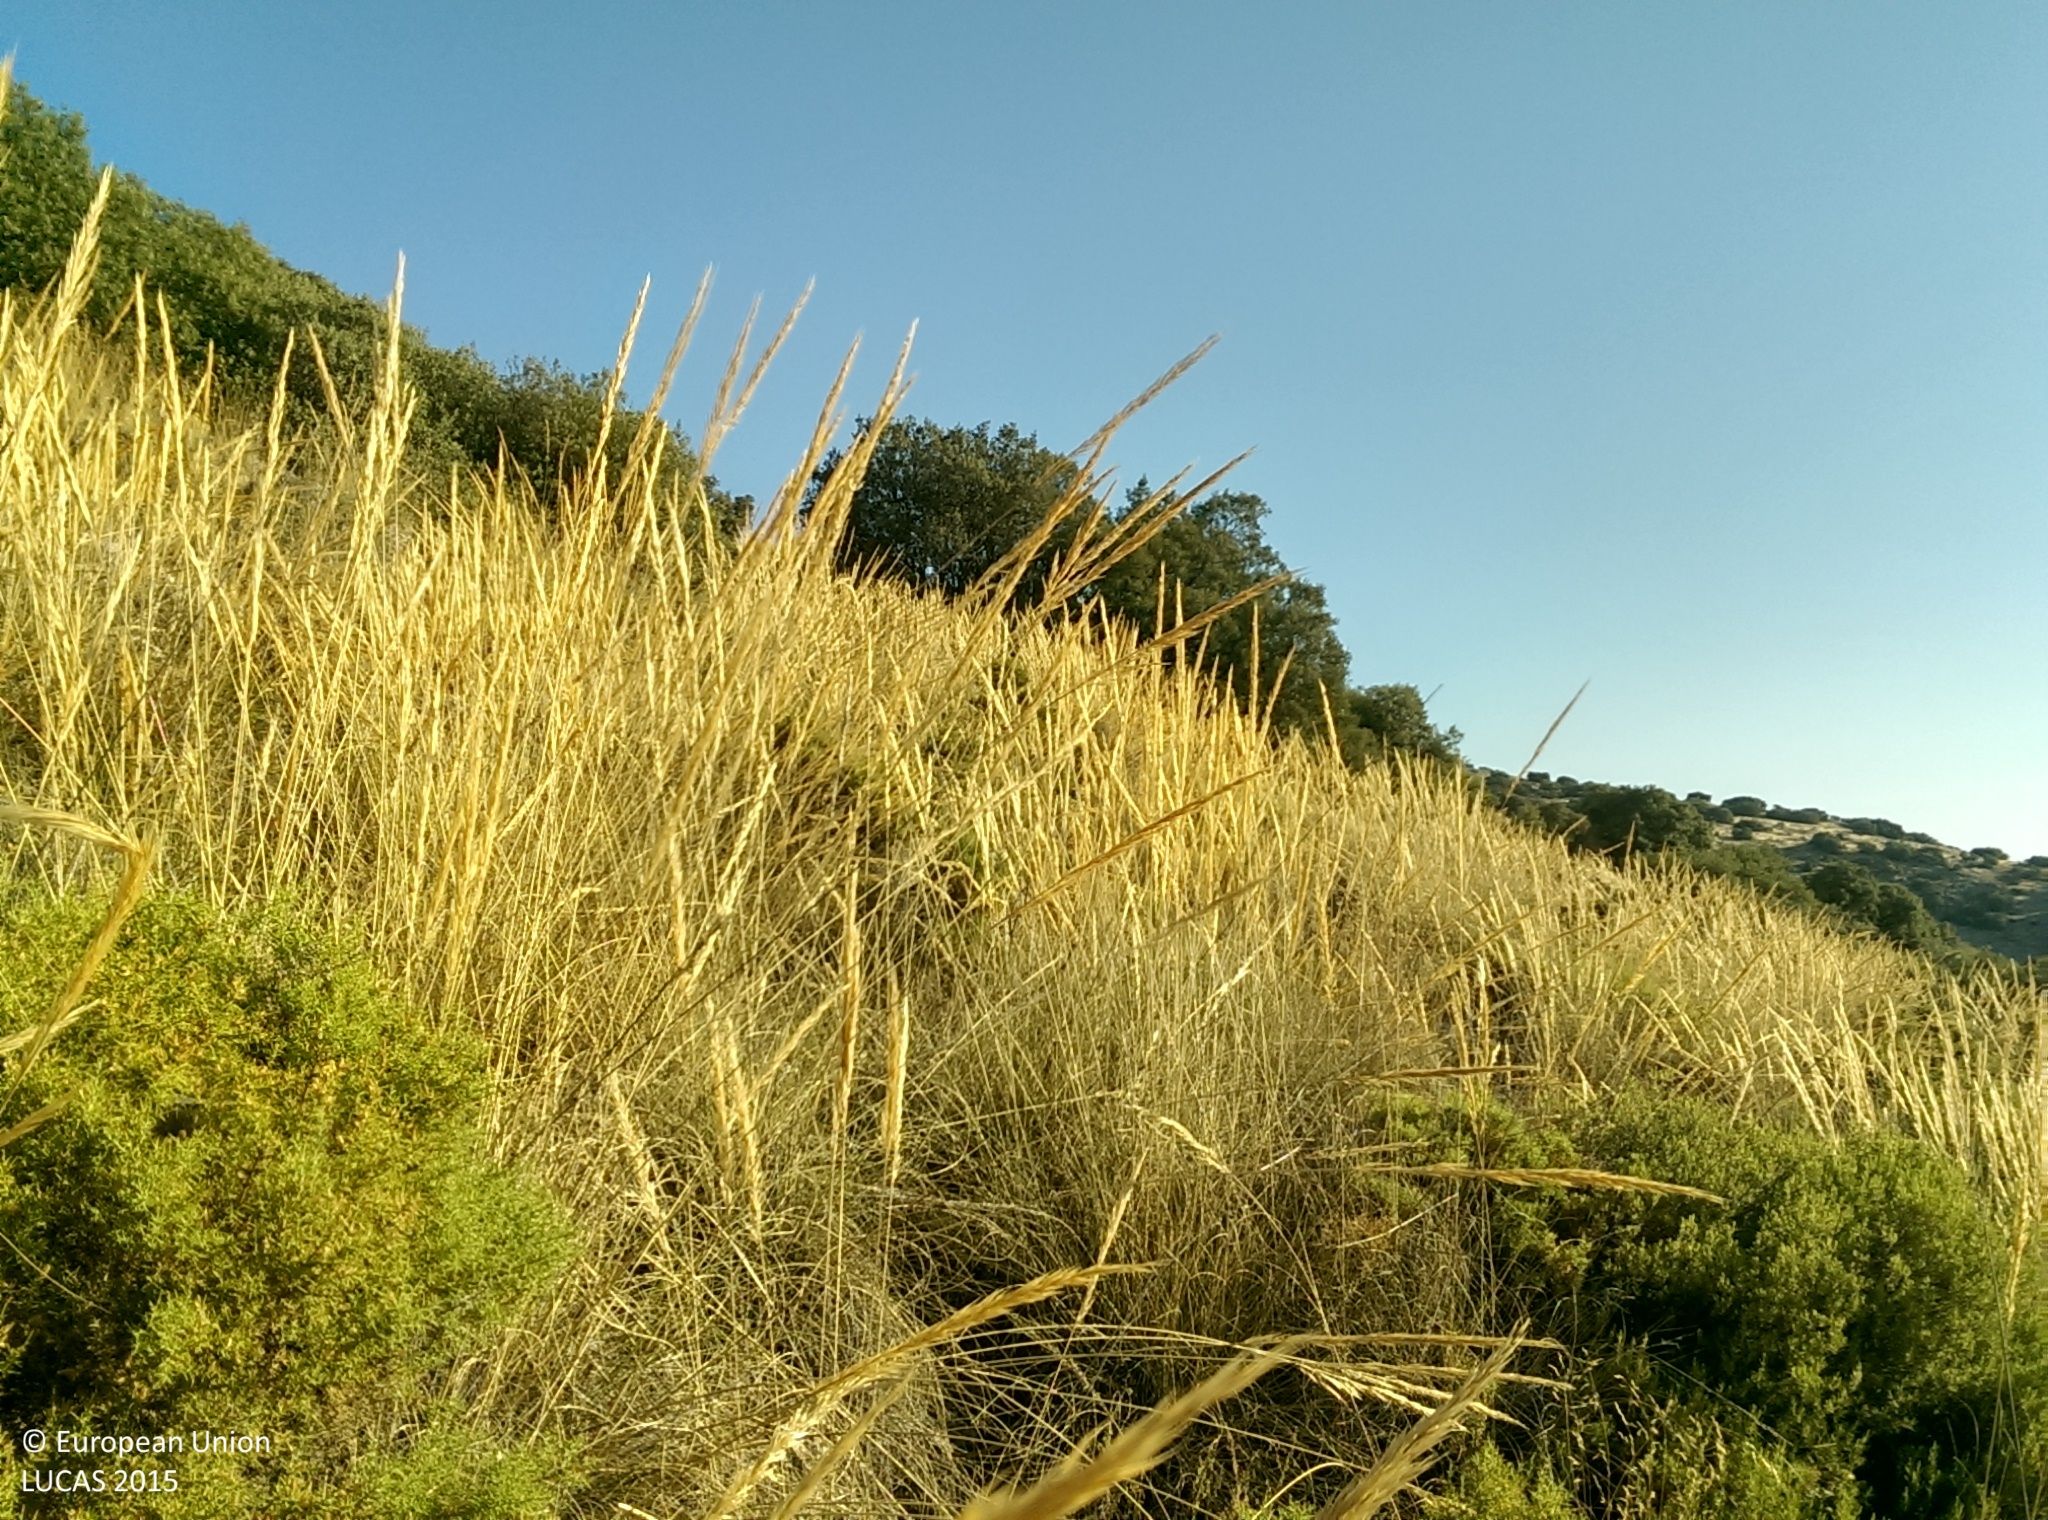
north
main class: Shrubland
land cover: Shrubland without tree cover
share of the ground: 10 - 25 %
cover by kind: herbaceous plants 85 %, shrubs 10 %, consolidated bare surface 5 %
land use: Semi-natural and natural areas not in use
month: July
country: ES
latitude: 37.3879
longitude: -3.7396
